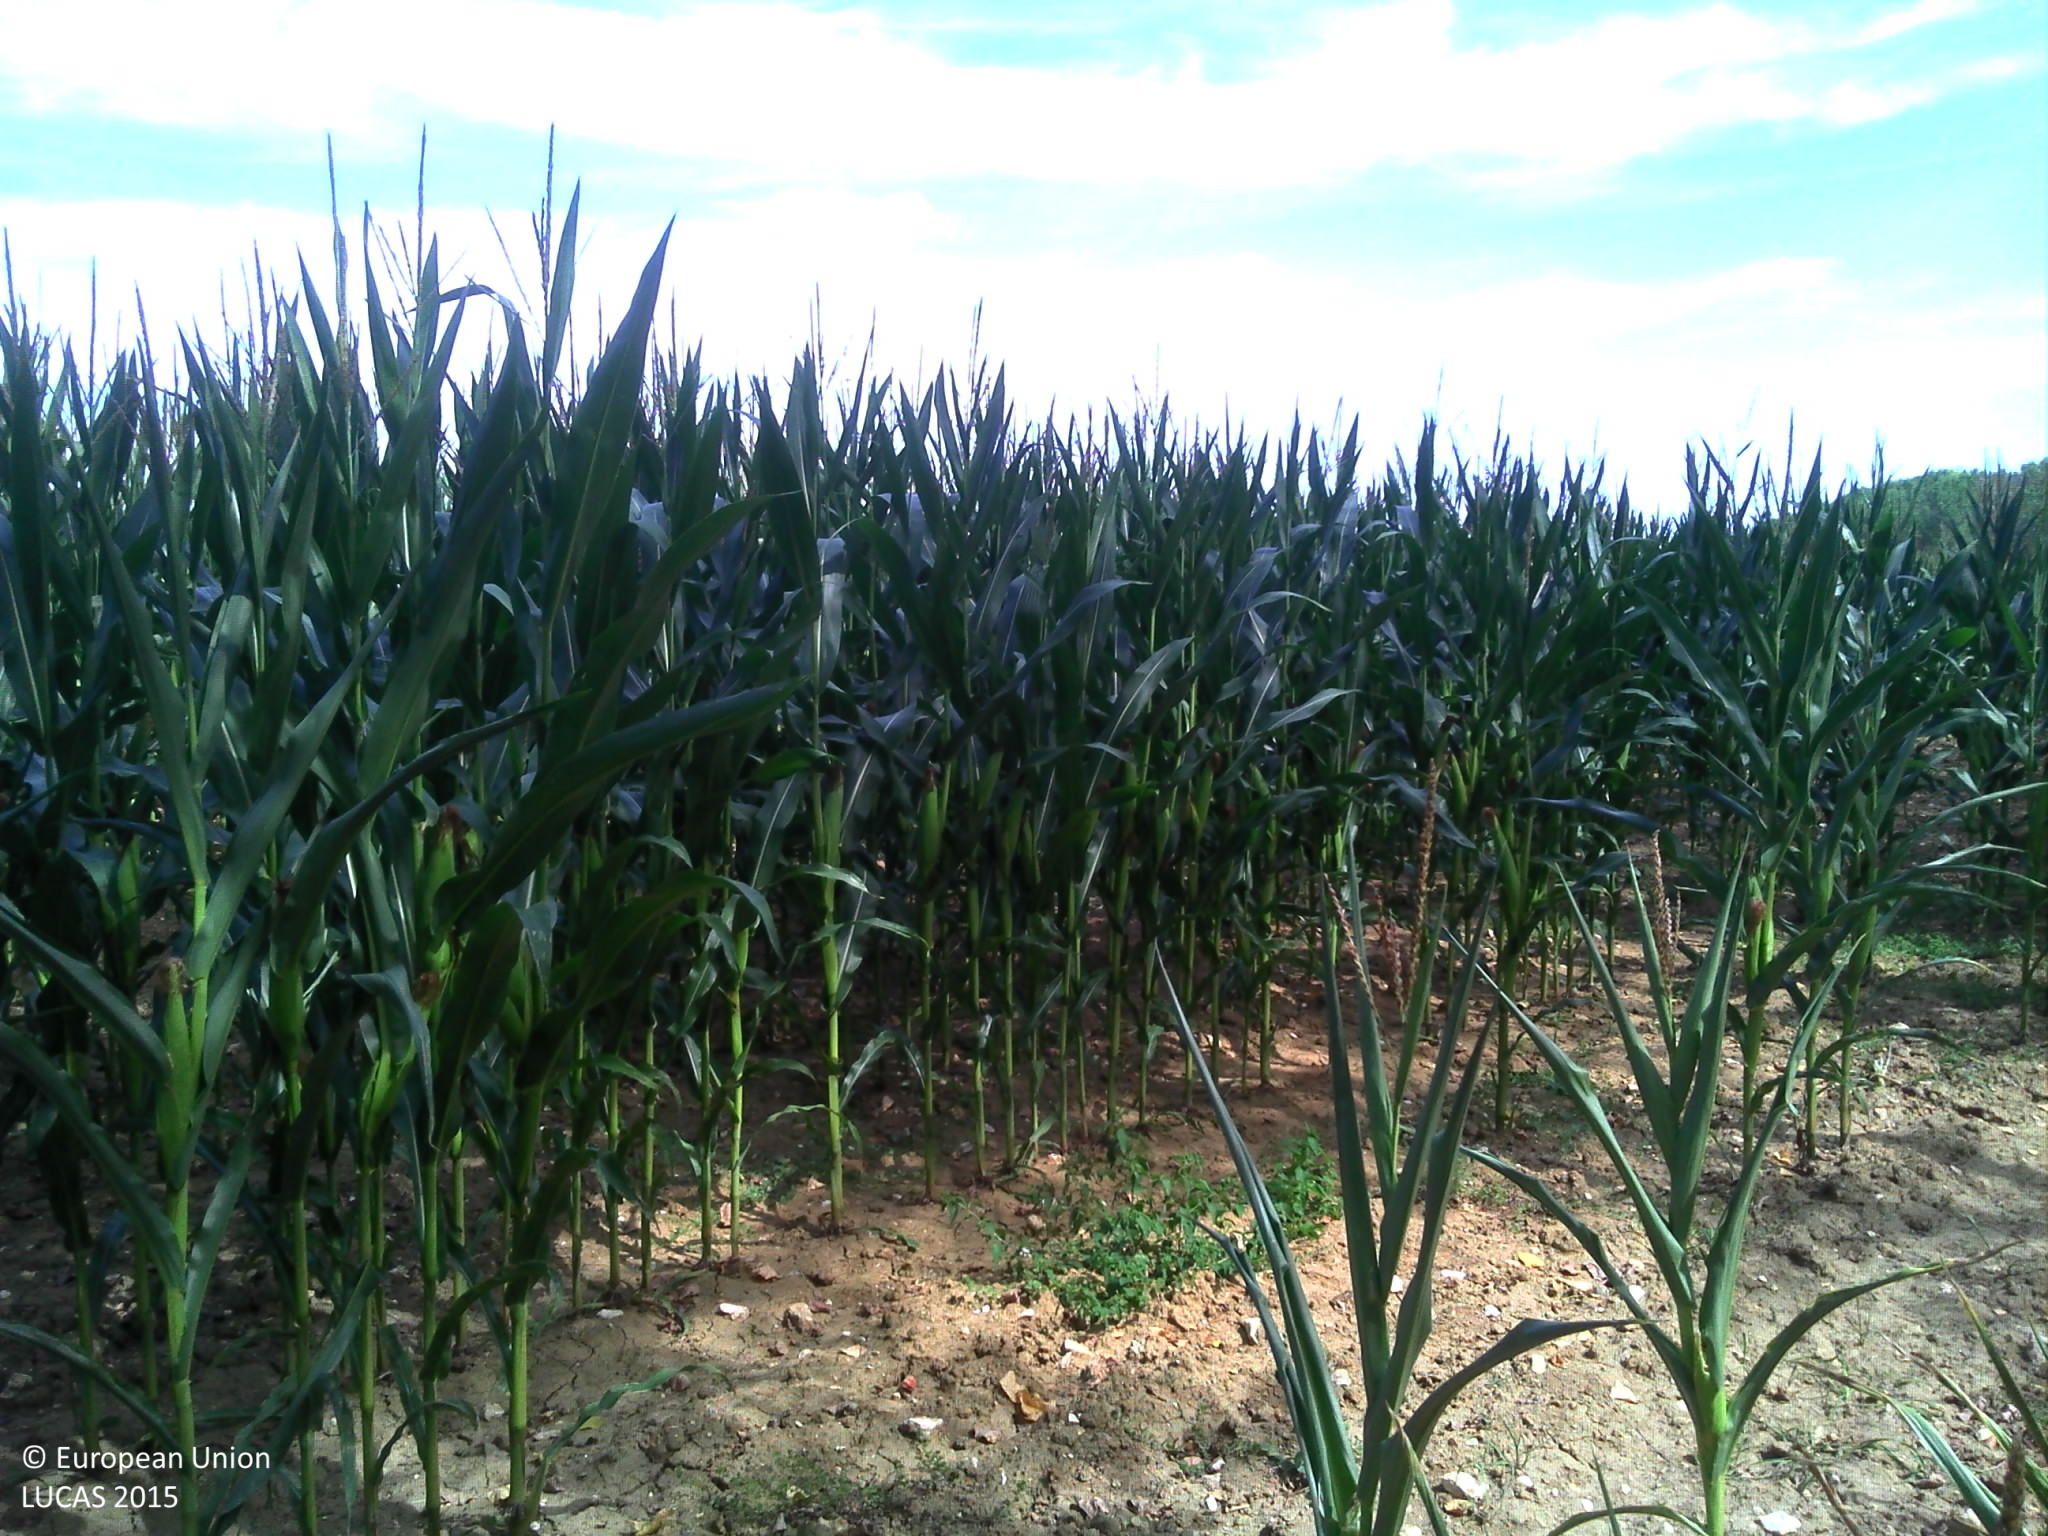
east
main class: Woodland
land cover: Broadleaved woodland
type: exotic forest
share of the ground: > 75 %
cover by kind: broadleaved forest trees 55 %, herbaceous plants 15 %, lichens and mosses 15 %, unconsolidated bare surface 5 %
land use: Forestry
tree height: > 5 m
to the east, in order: Broadleaved woodland; Maize; Grass margins; Tracks; Grass margins; Common wheat
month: August
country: FR
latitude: 48.6890
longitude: 3.3231
